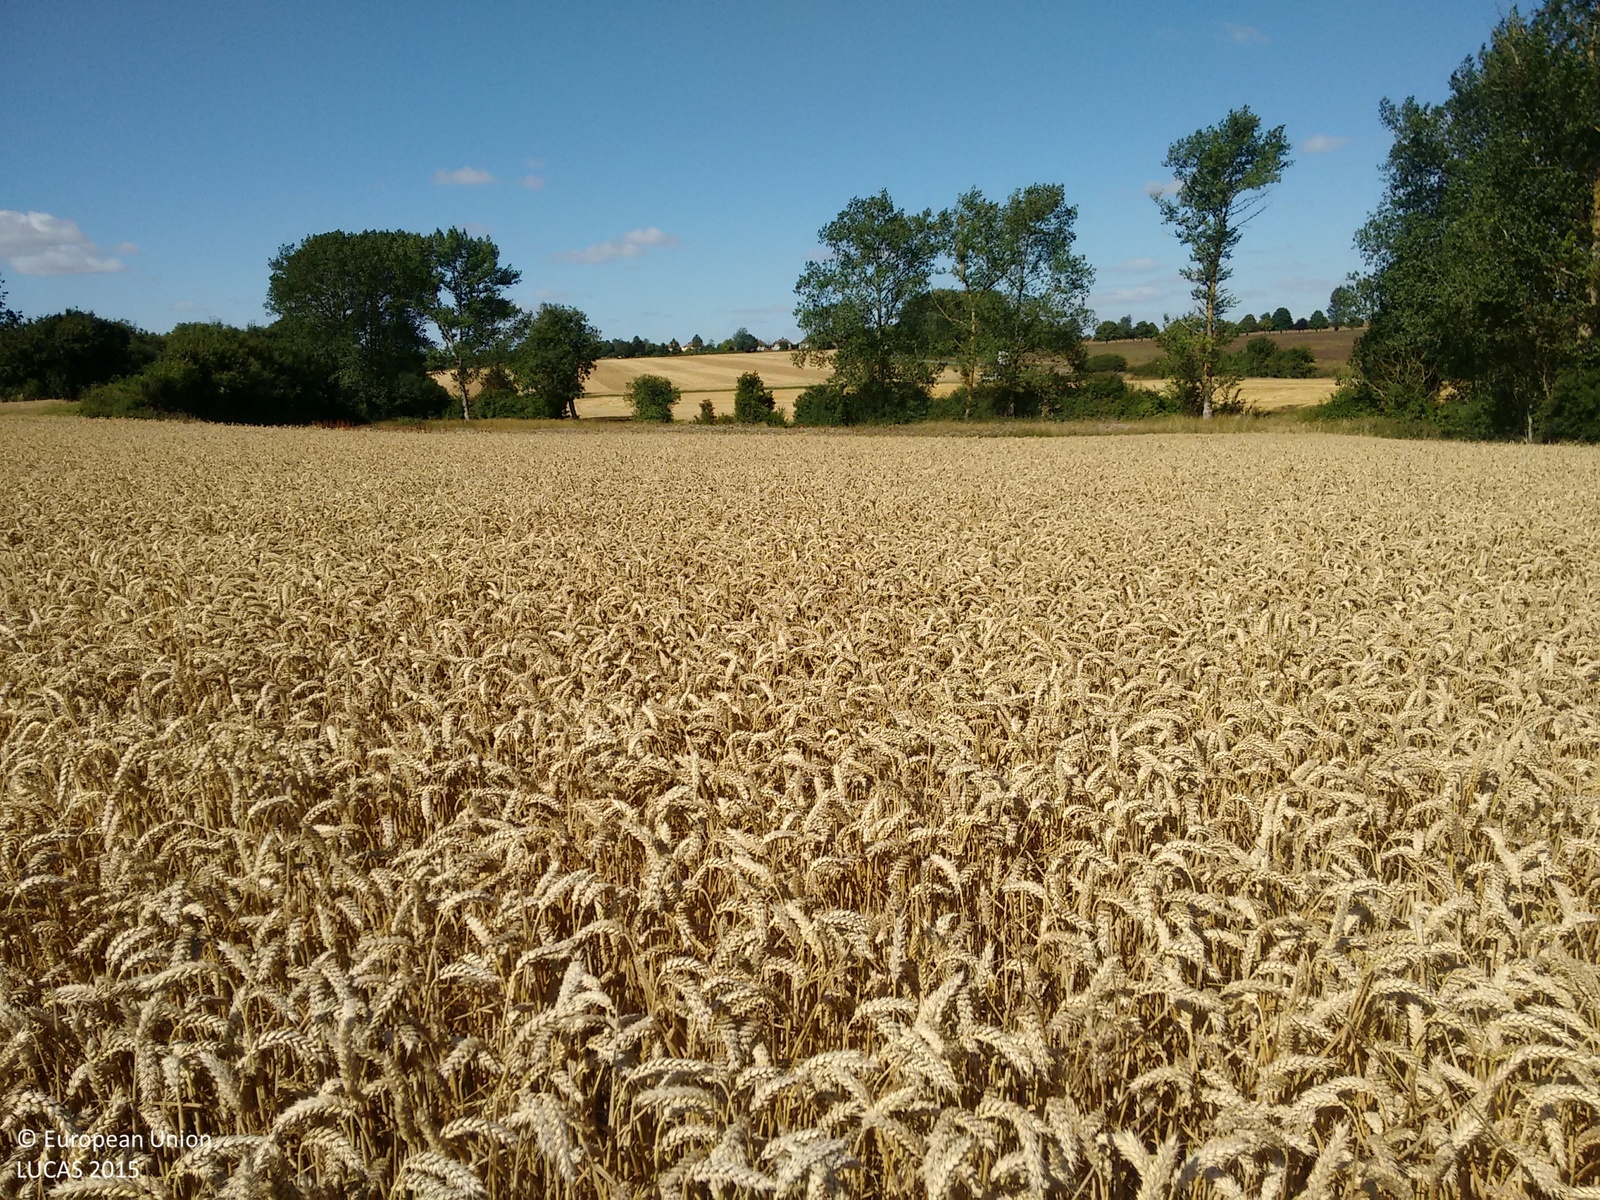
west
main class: Cropland
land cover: Common wheat
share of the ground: > 75 %
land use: Agriculture (excluding fallow land and kitchen gardens)
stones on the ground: 25 - 50 %
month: August
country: GB
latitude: 52.0947
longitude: 0.3811
